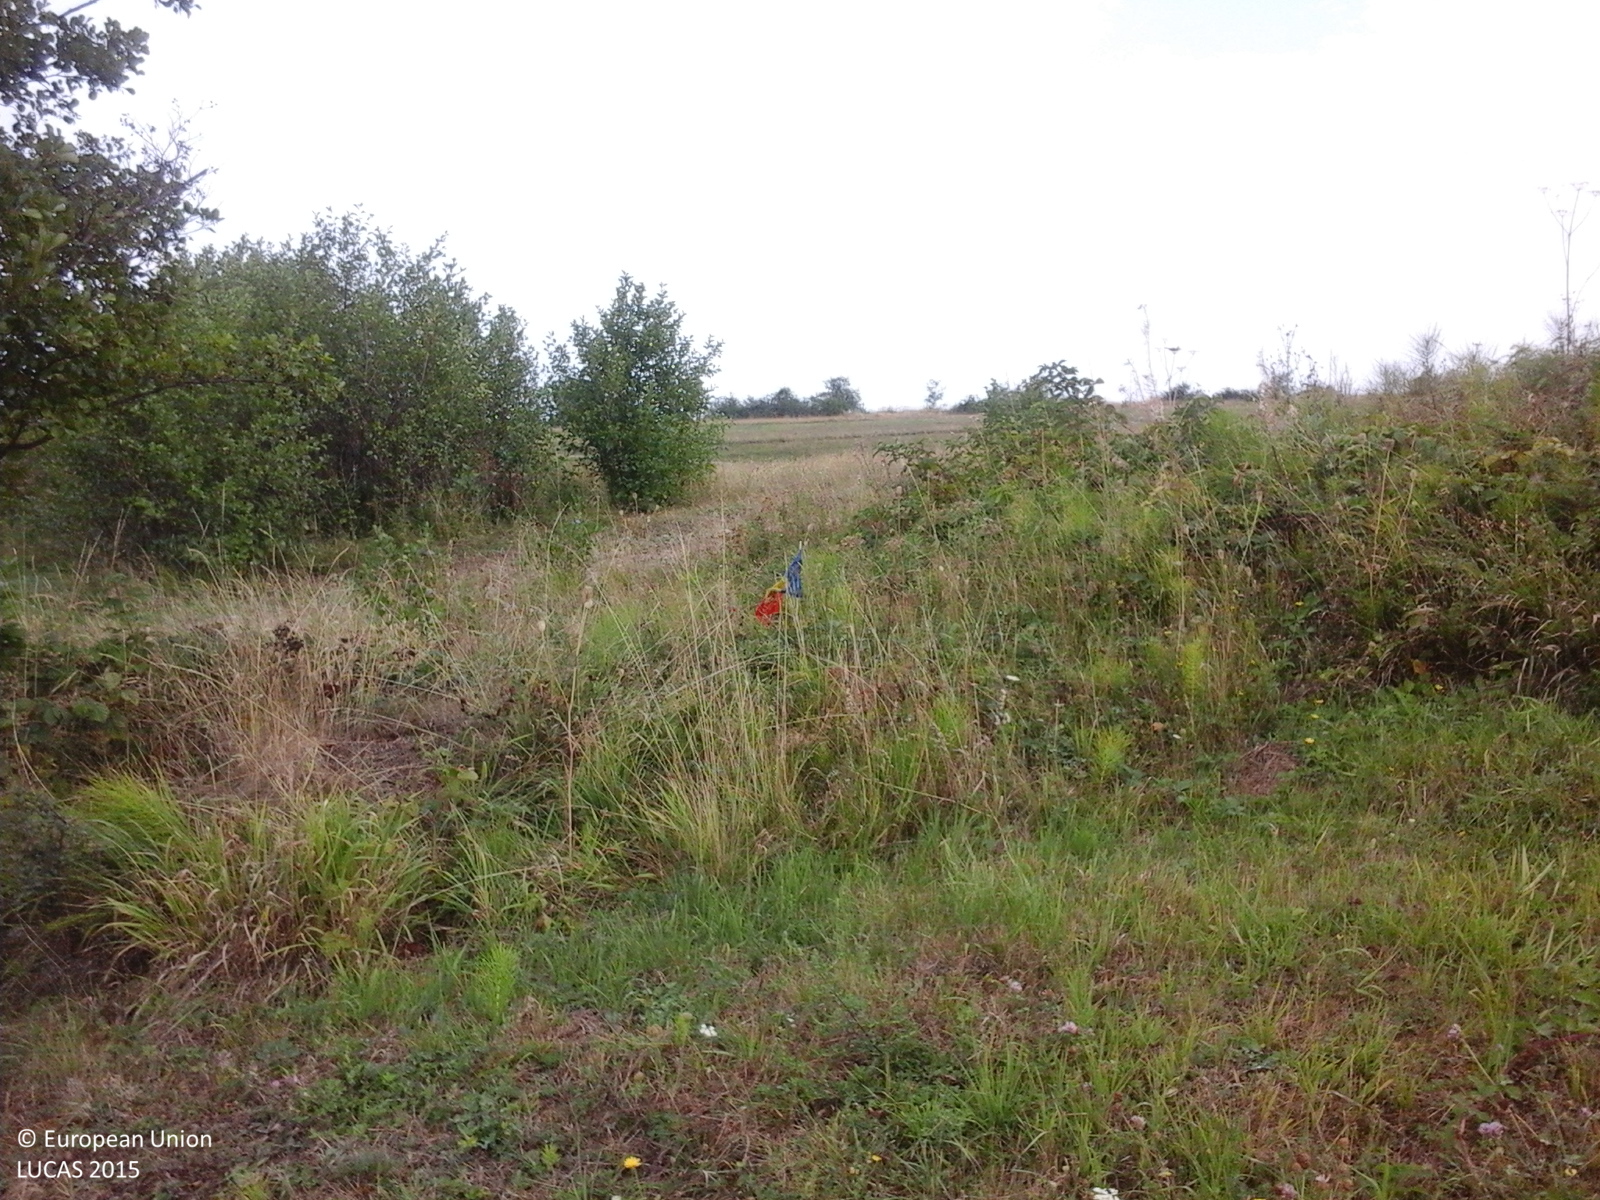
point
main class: Grassland
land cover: Spontaneously vegetated surfaces
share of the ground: > 75 %
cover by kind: herbaceous plants 100 %
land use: Agriculture (excluding fallow land and kitchen gardens)
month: September
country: RO
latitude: 47.7662
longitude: 23.9740
